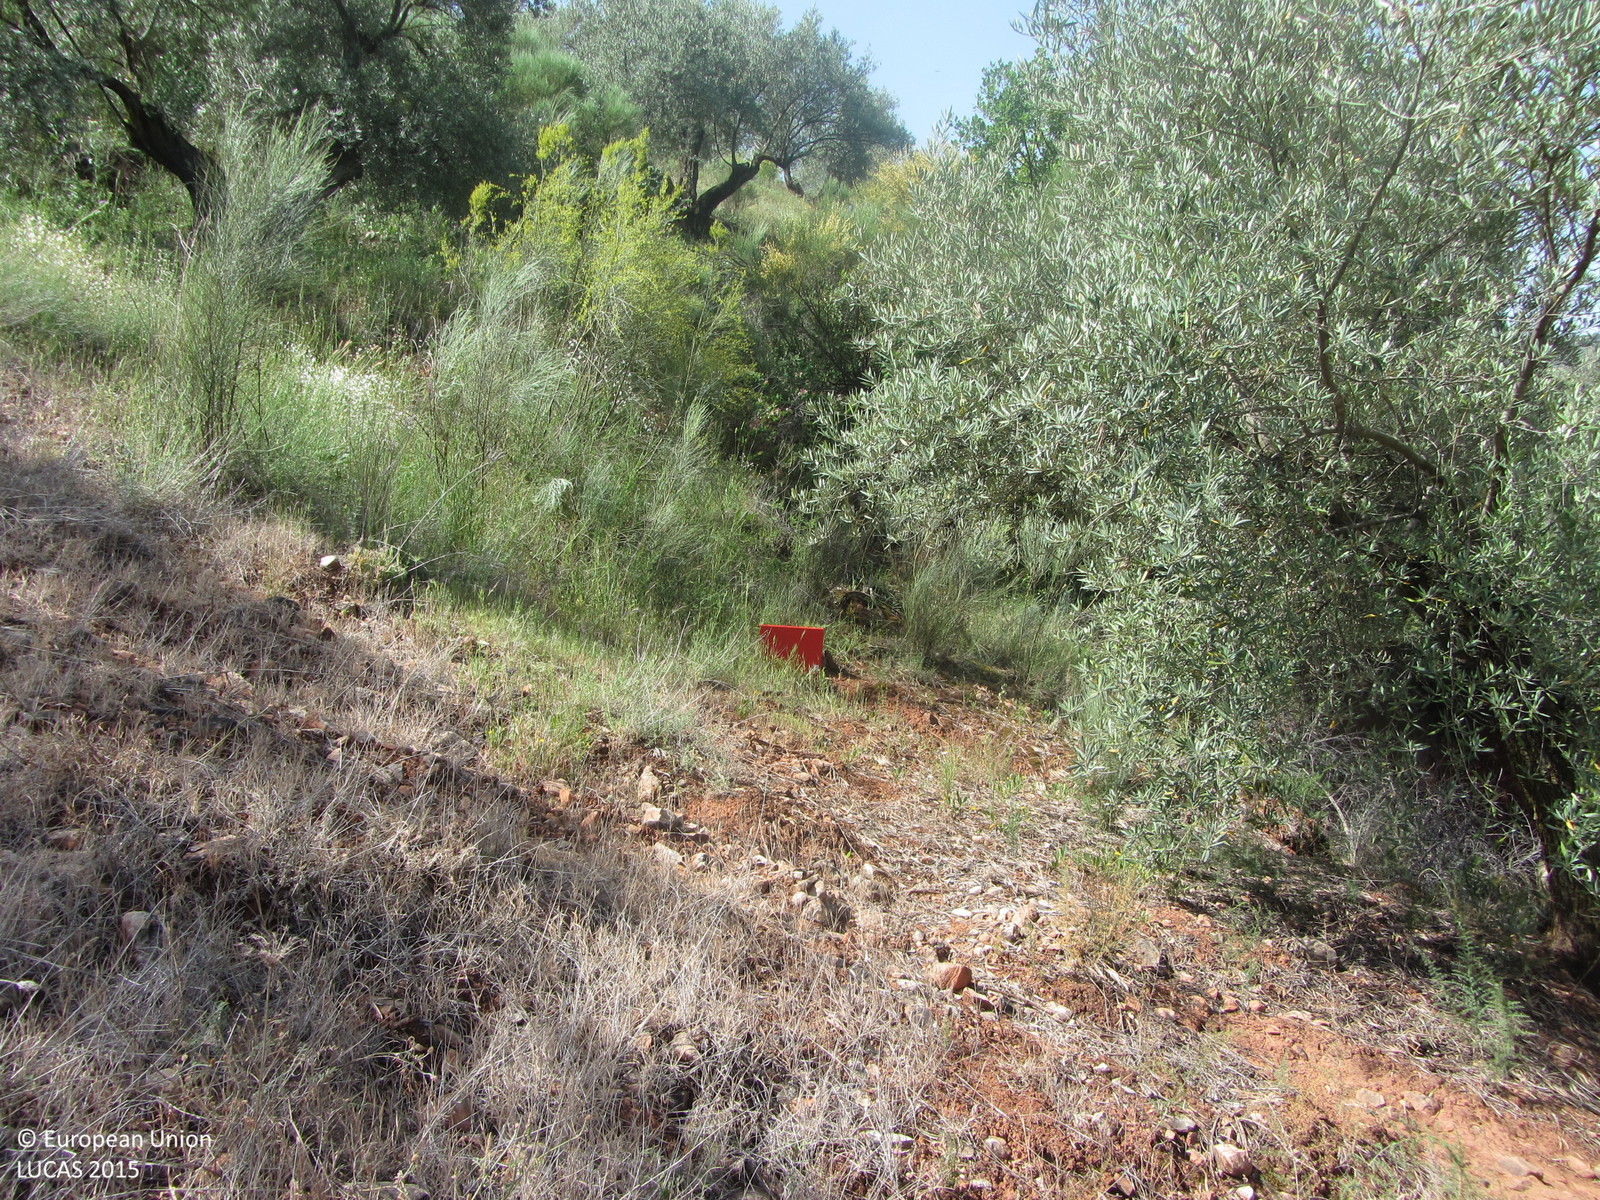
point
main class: Cropland
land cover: Olive groves
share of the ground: 25 - 50 %
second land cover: Spontaneously vegetated surfaces
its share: 10 - 25 %
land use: Agriculture (excluding fallow land and kitchen gardens)
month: May
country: ES
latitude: 38.2574
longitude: -3.0399
